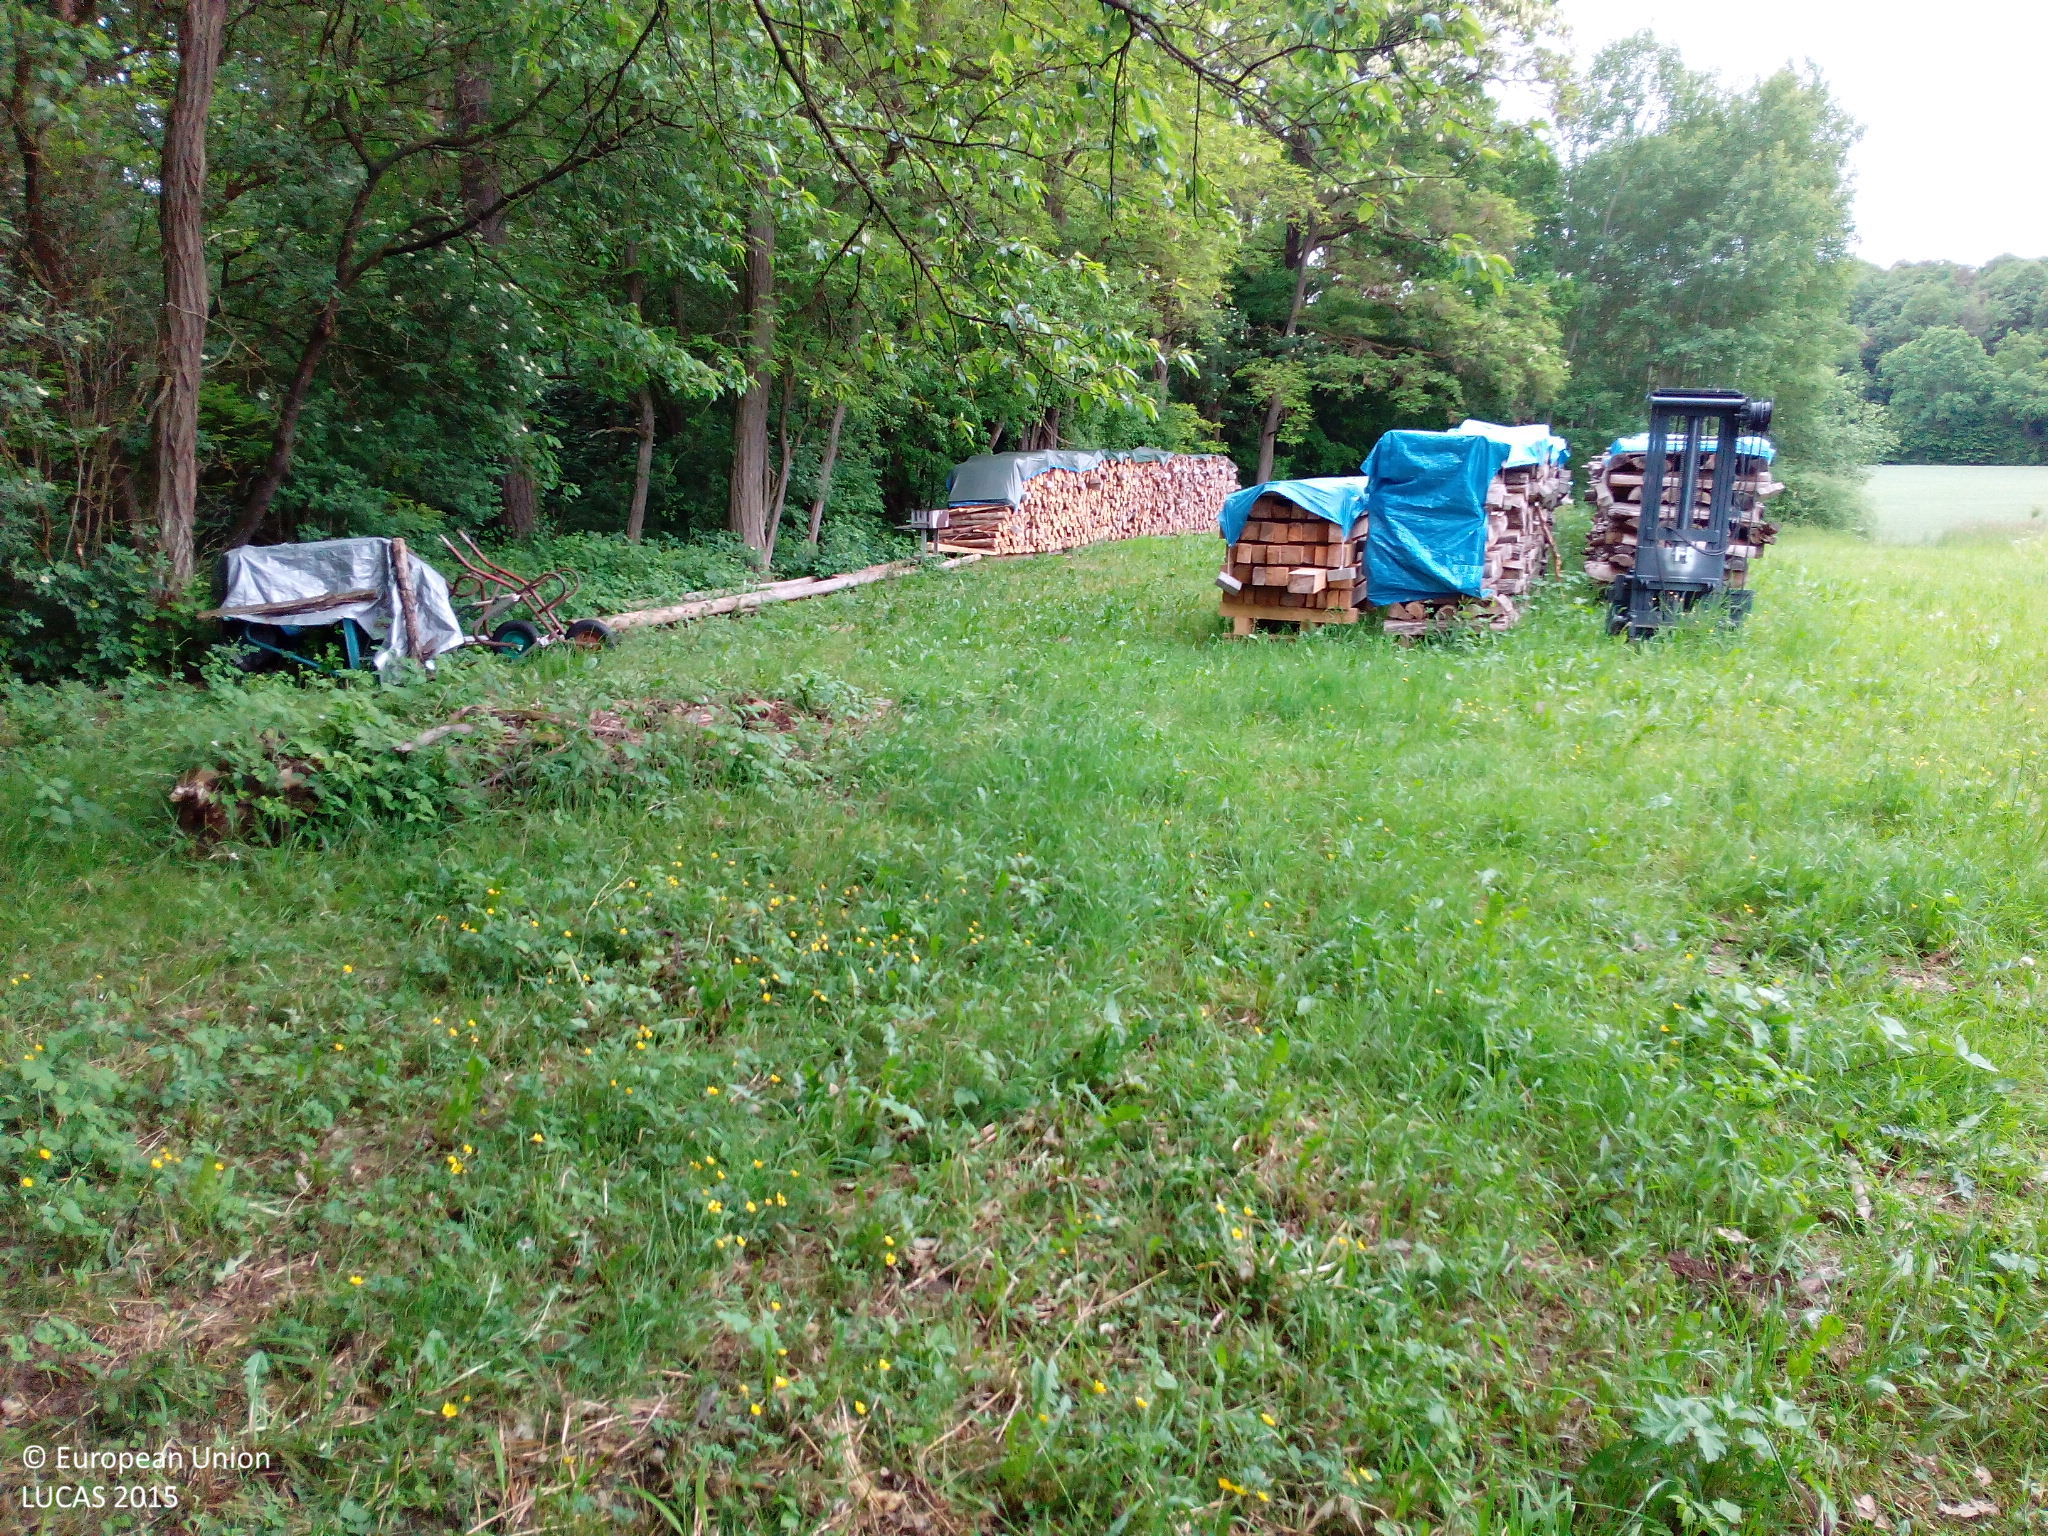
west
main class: Grassland
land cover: Grassland without tree/shrub cover
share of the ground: > 75 %
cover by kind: herbaceous plants 100 %
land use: Agriculture (excluding fallow land and kitchen gardens)
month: June
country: DE
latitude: 50.0367
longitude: 10.9072
